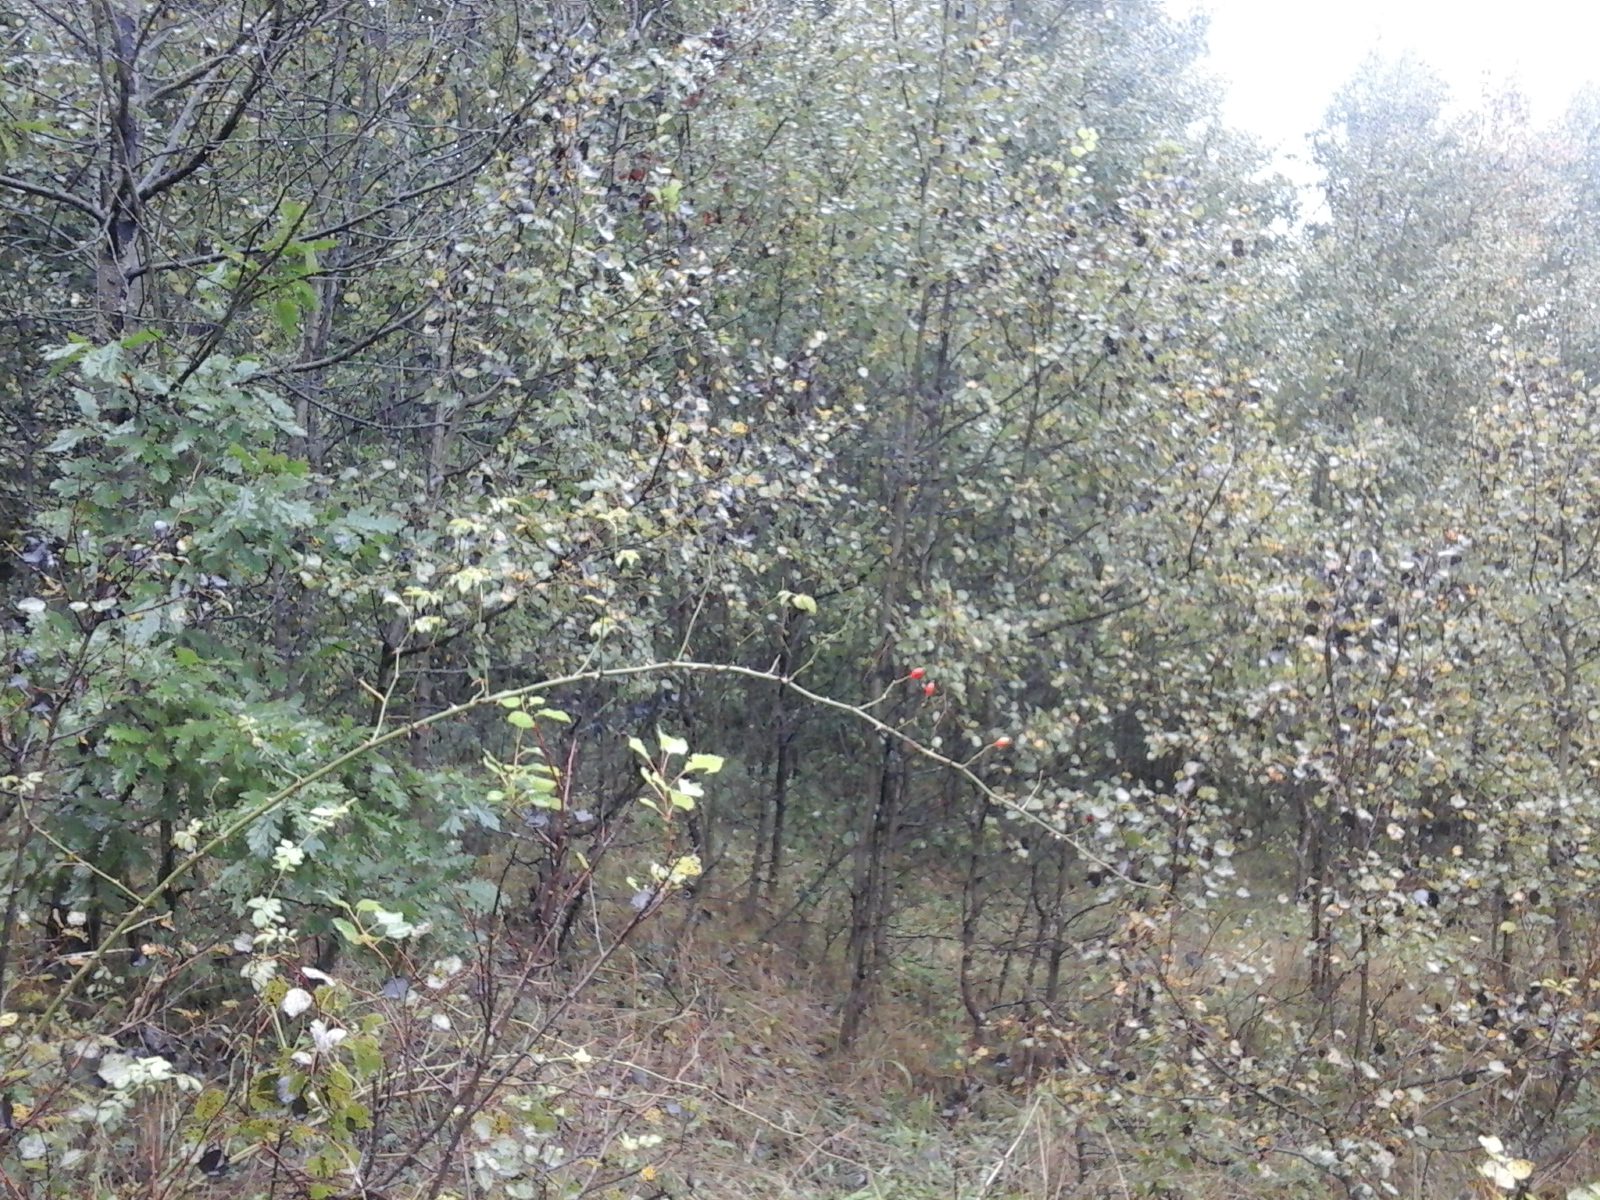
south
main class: Grassland
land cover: Grassland with sparse tree/shrub cover
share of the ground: > 75 %
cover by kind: herbaceous plants 85 %, shrubs 10 %, broadleaved forest trees 5 %
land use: Fallow land
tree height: < 5 m
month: September
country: RO
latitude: 44.8844
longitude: 23.6692
